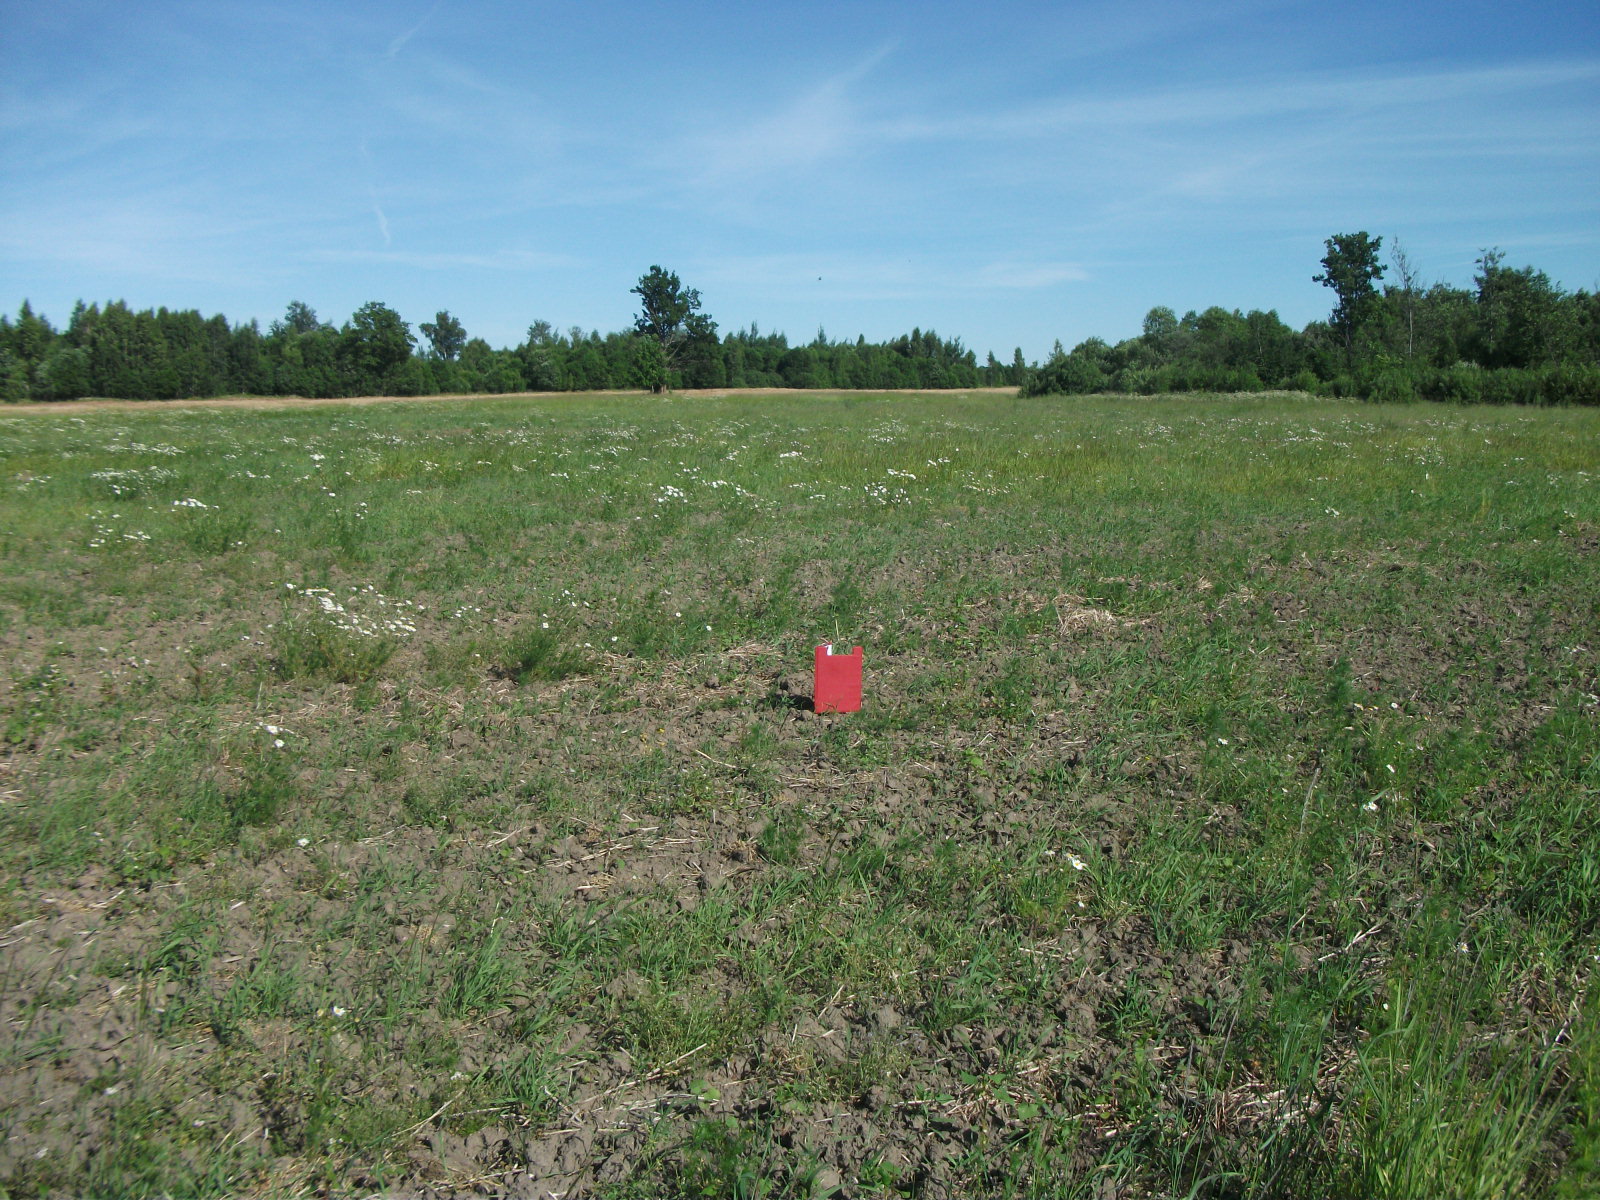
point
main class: Grassland
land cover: Spontaneously vegetated surfaces
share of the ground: > 75 %
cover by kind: herbaceous plants 80 %, unconsolidated bare surface 20 %
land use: Fallow land
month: July
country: LV
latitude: 56.7436
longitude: 26.3790
